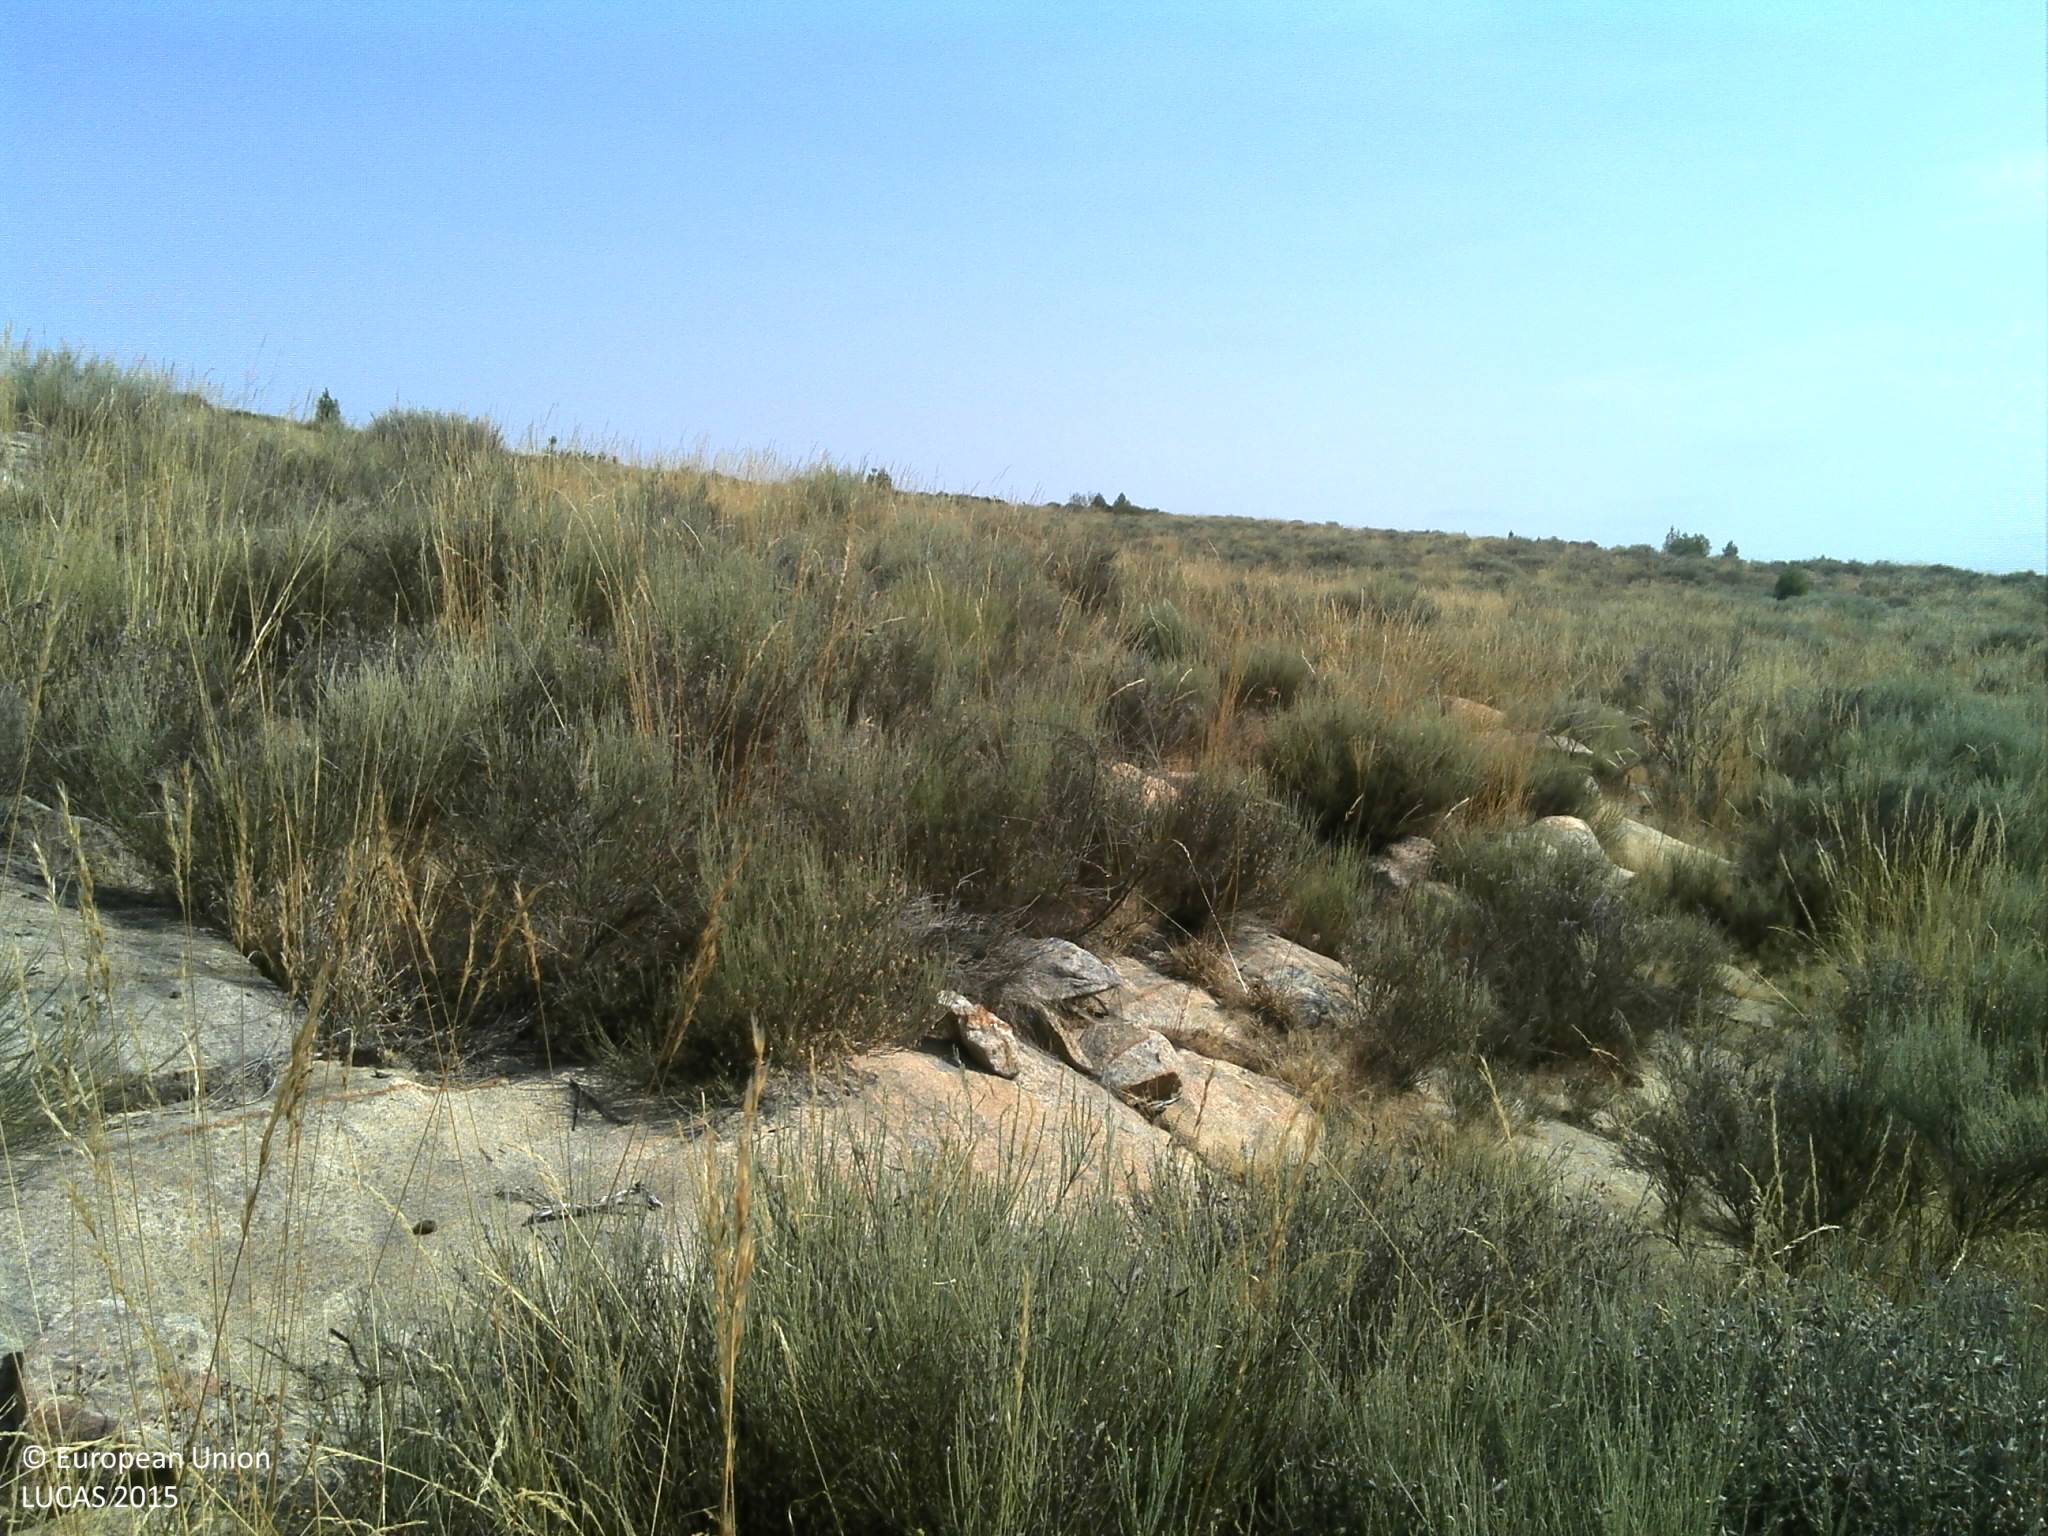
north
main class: Shrubland
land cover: Shrubland without tree cover
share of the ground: 50 - 75 %
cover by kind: shrubs 55 %, herbaceous plants 15 %, consolidated bare surface 15 %, unconsolidated bare surface 15 %
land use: Semi-natural and natural areas not in use
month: July
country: PT
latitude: 40.9539
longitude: -7.3774
